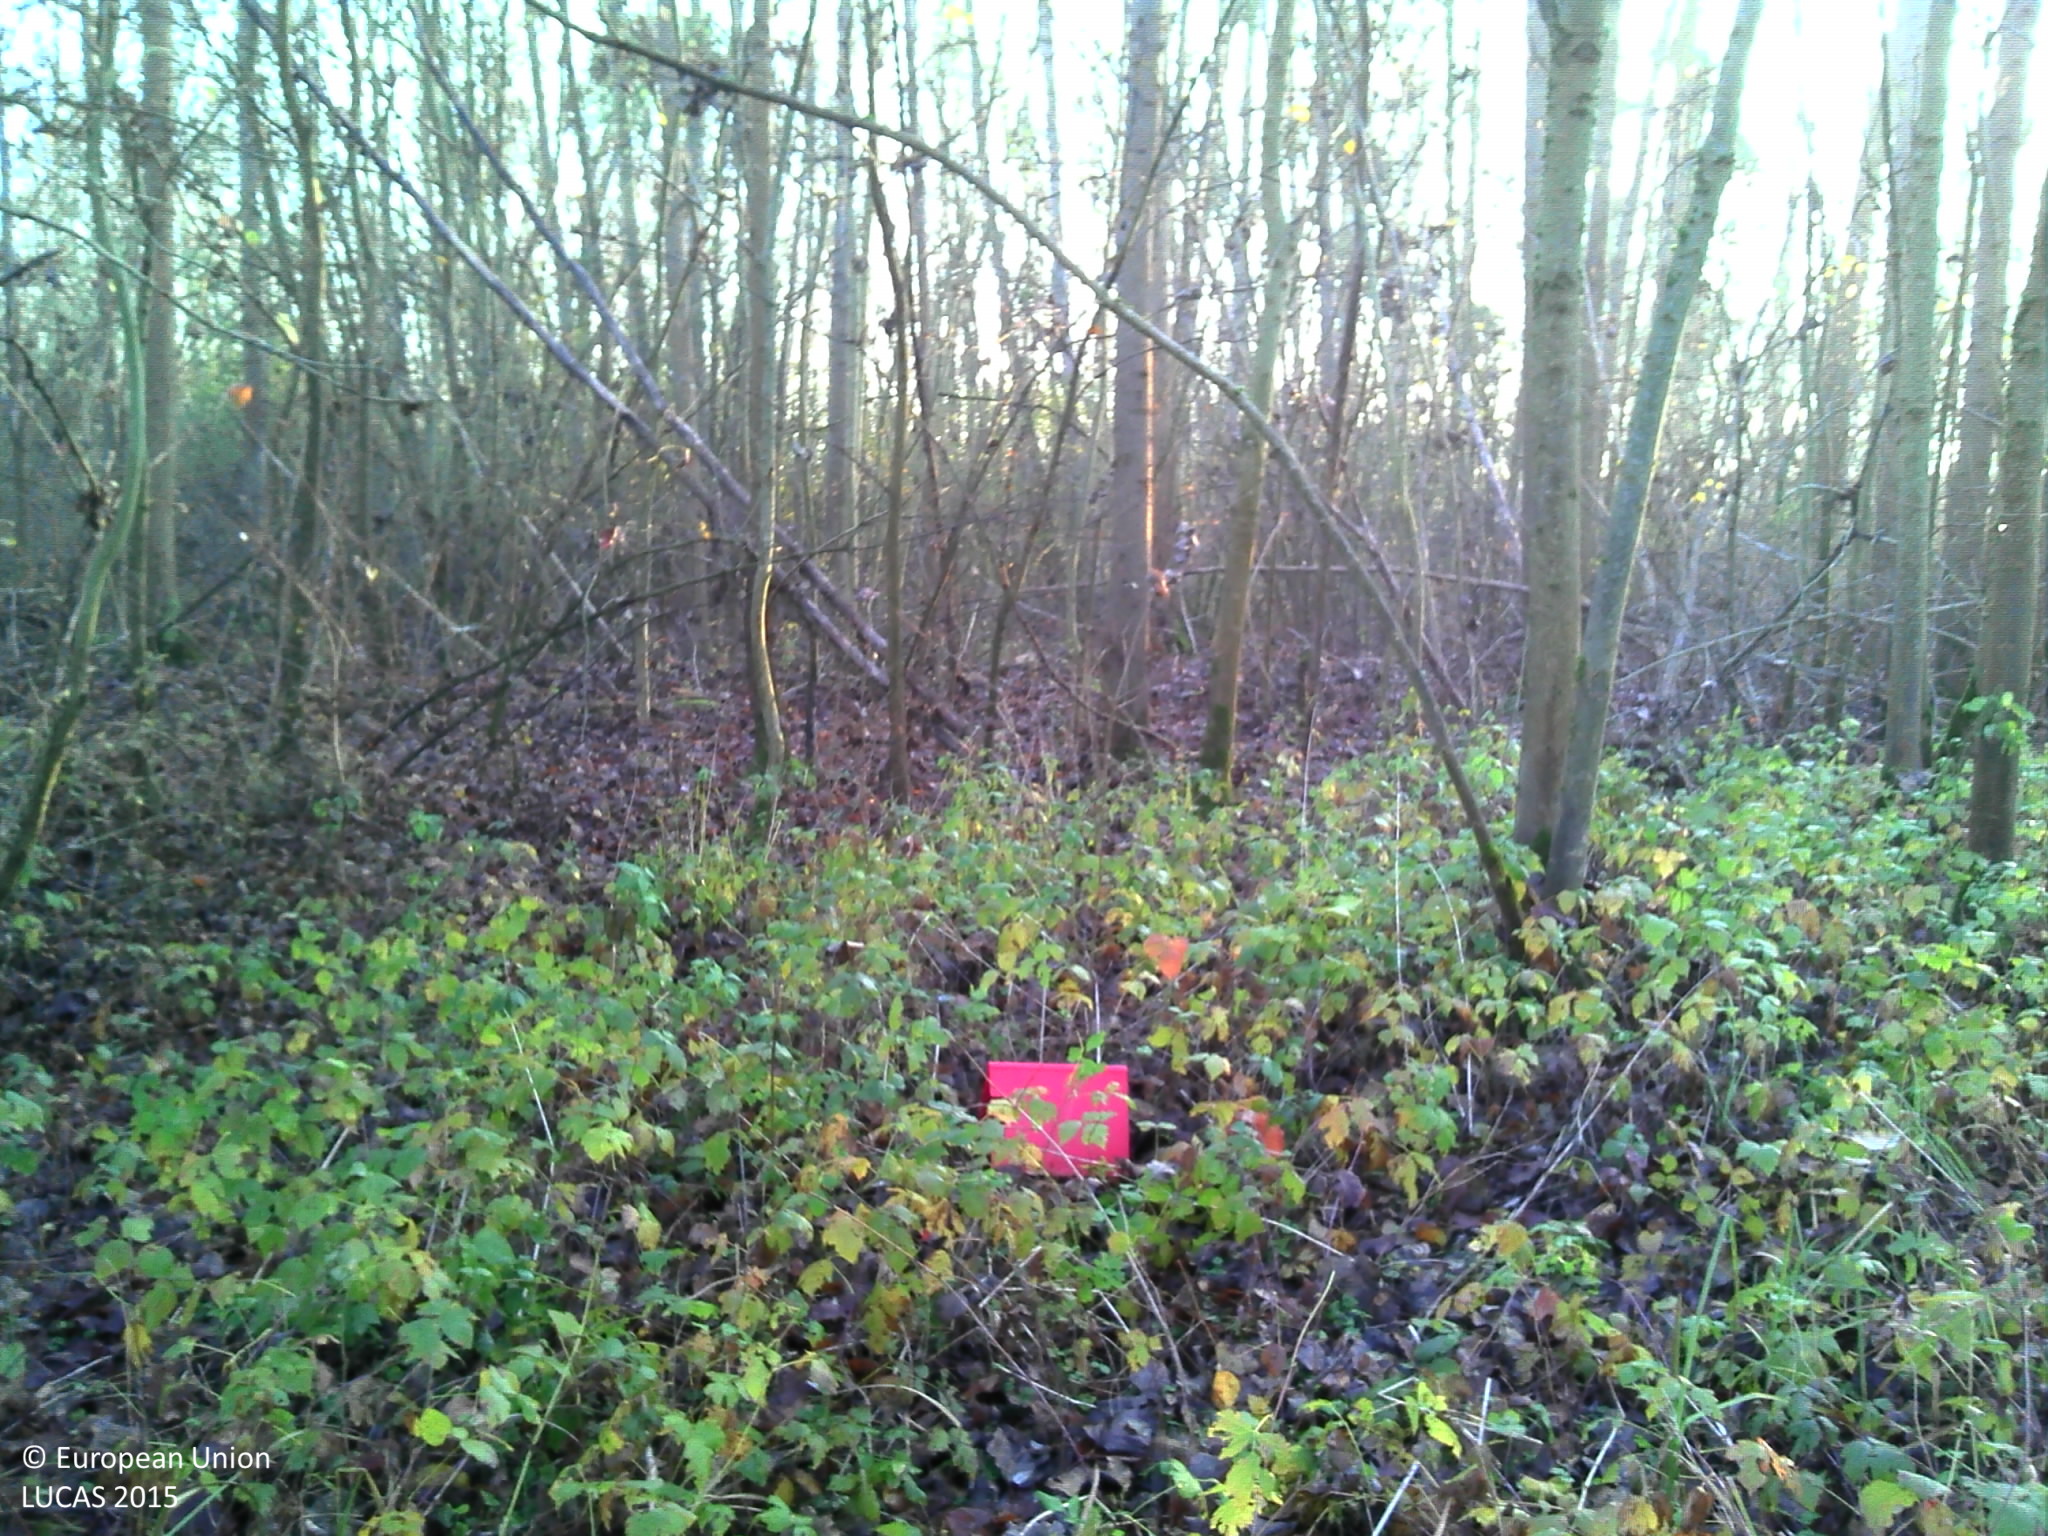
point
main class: Woodland
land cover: Broadleaved woodland
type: floodplain forest
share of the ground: > 75 %
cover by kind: broadleaved forest trees 90 %, herbaceous plants 10 %
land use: Semi-natural and natural areas not in use
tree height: > 5 m
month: December
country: FR
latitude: 46.2621
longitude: 4.8258
